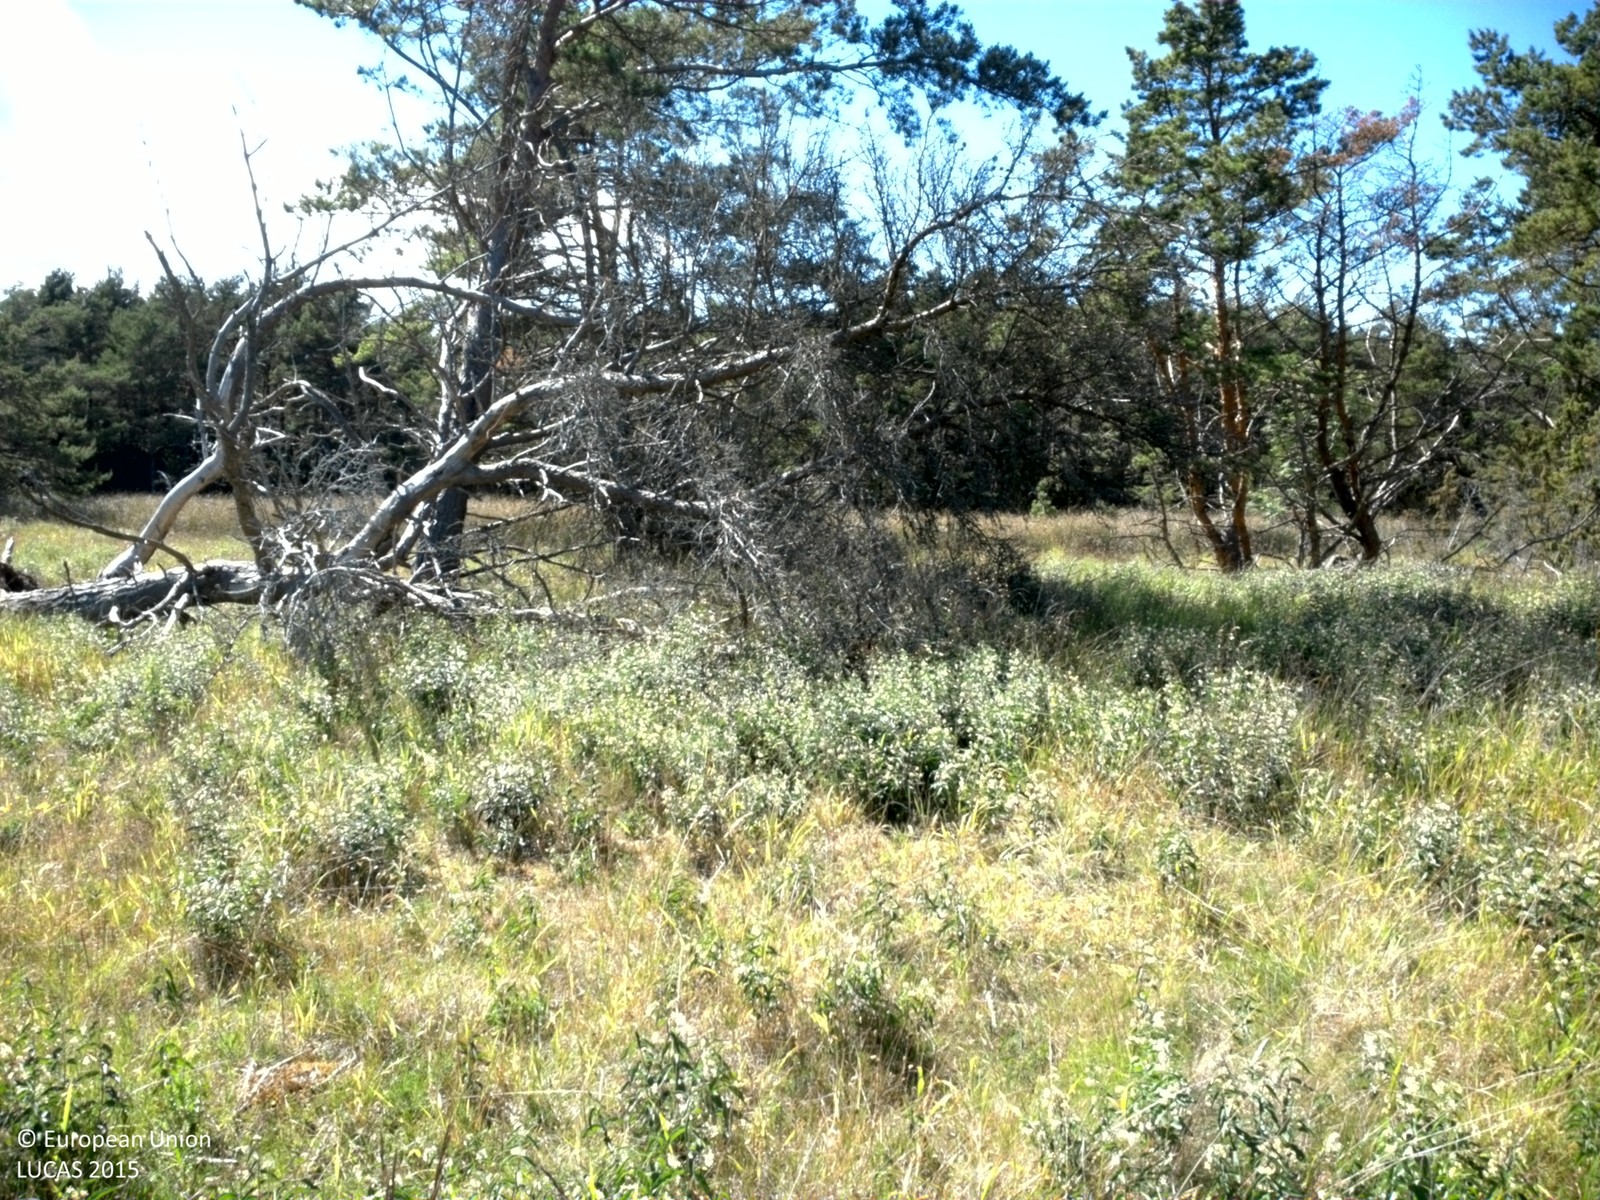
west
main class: Grassland
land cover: Grassland with sparse tree/shrub cover
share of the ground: > 75 %
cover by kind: herbaceous plants 95 %, coniferous forest trees 5 %
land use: Amenities, museums, leisure
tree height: > 5 m
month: July
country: SE
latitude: 57.8541
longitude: 19.1280
